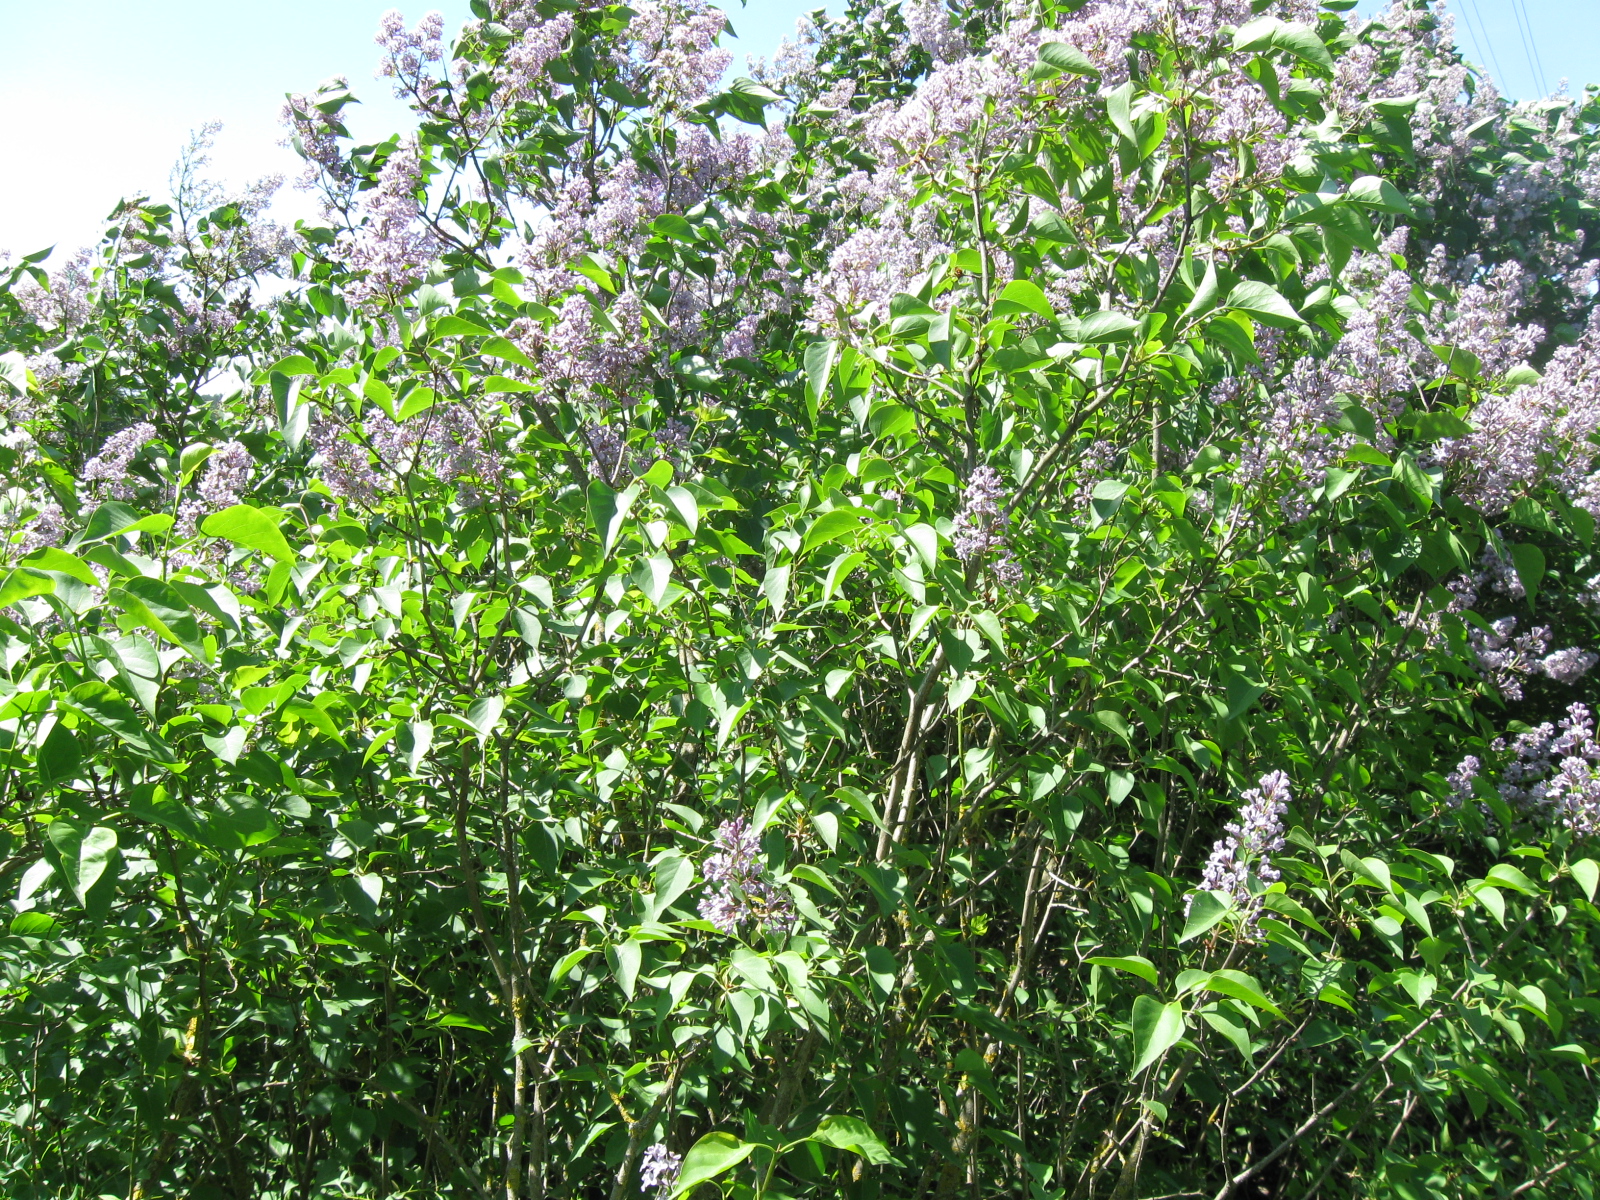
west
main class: Woodland
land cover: Broadleaved woodland
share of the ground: 25 - 50 %
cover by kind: broadleaved forest trees 45 %, herbaceous plants 40 %, shrubs 15 %
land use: Forestry
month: June
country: LT
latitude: 54.0949
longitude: 23.5547
